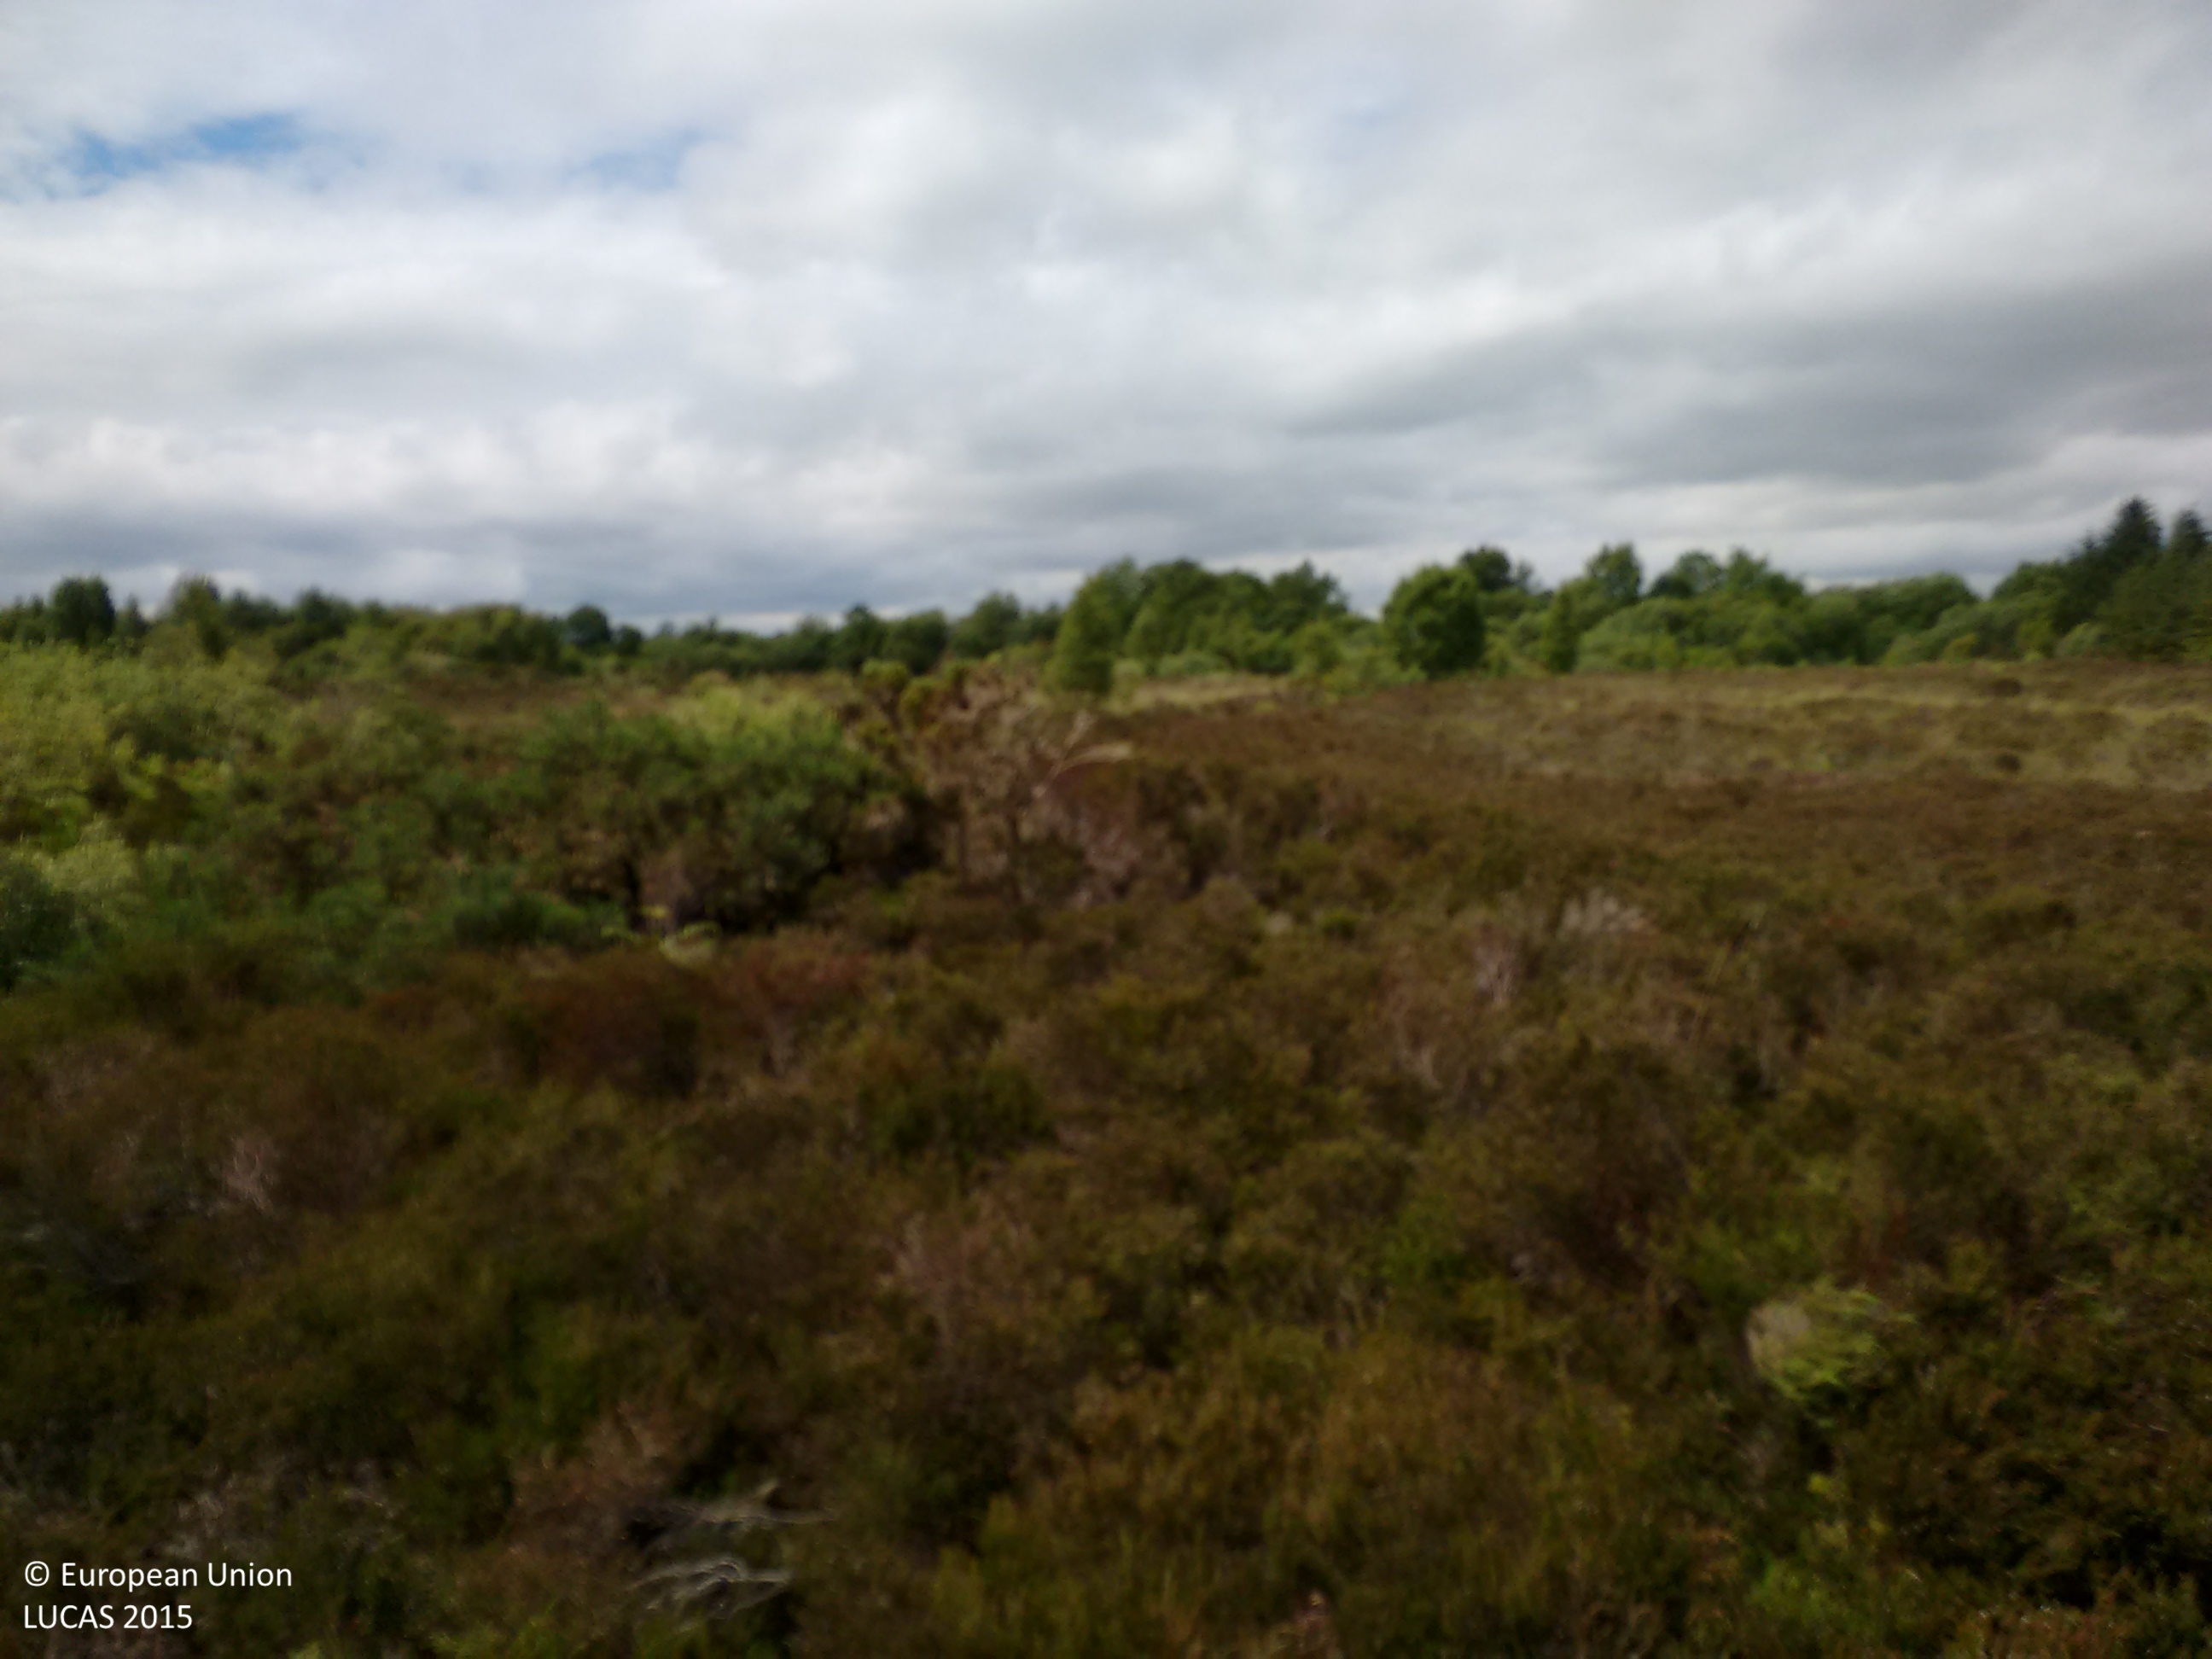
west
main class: Shrubland
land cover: Shrubland with sparse tree cover
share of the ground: > 75 %
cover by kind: shrubs 80 %, lichens and mosses 10 %, broadleaved forest trees 5 %, herbaceous plants 5 %
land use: Semi-natural and natural areas not in use
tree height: < 5 m
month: June
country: IE
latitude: 53.4280
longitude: -8.0722
